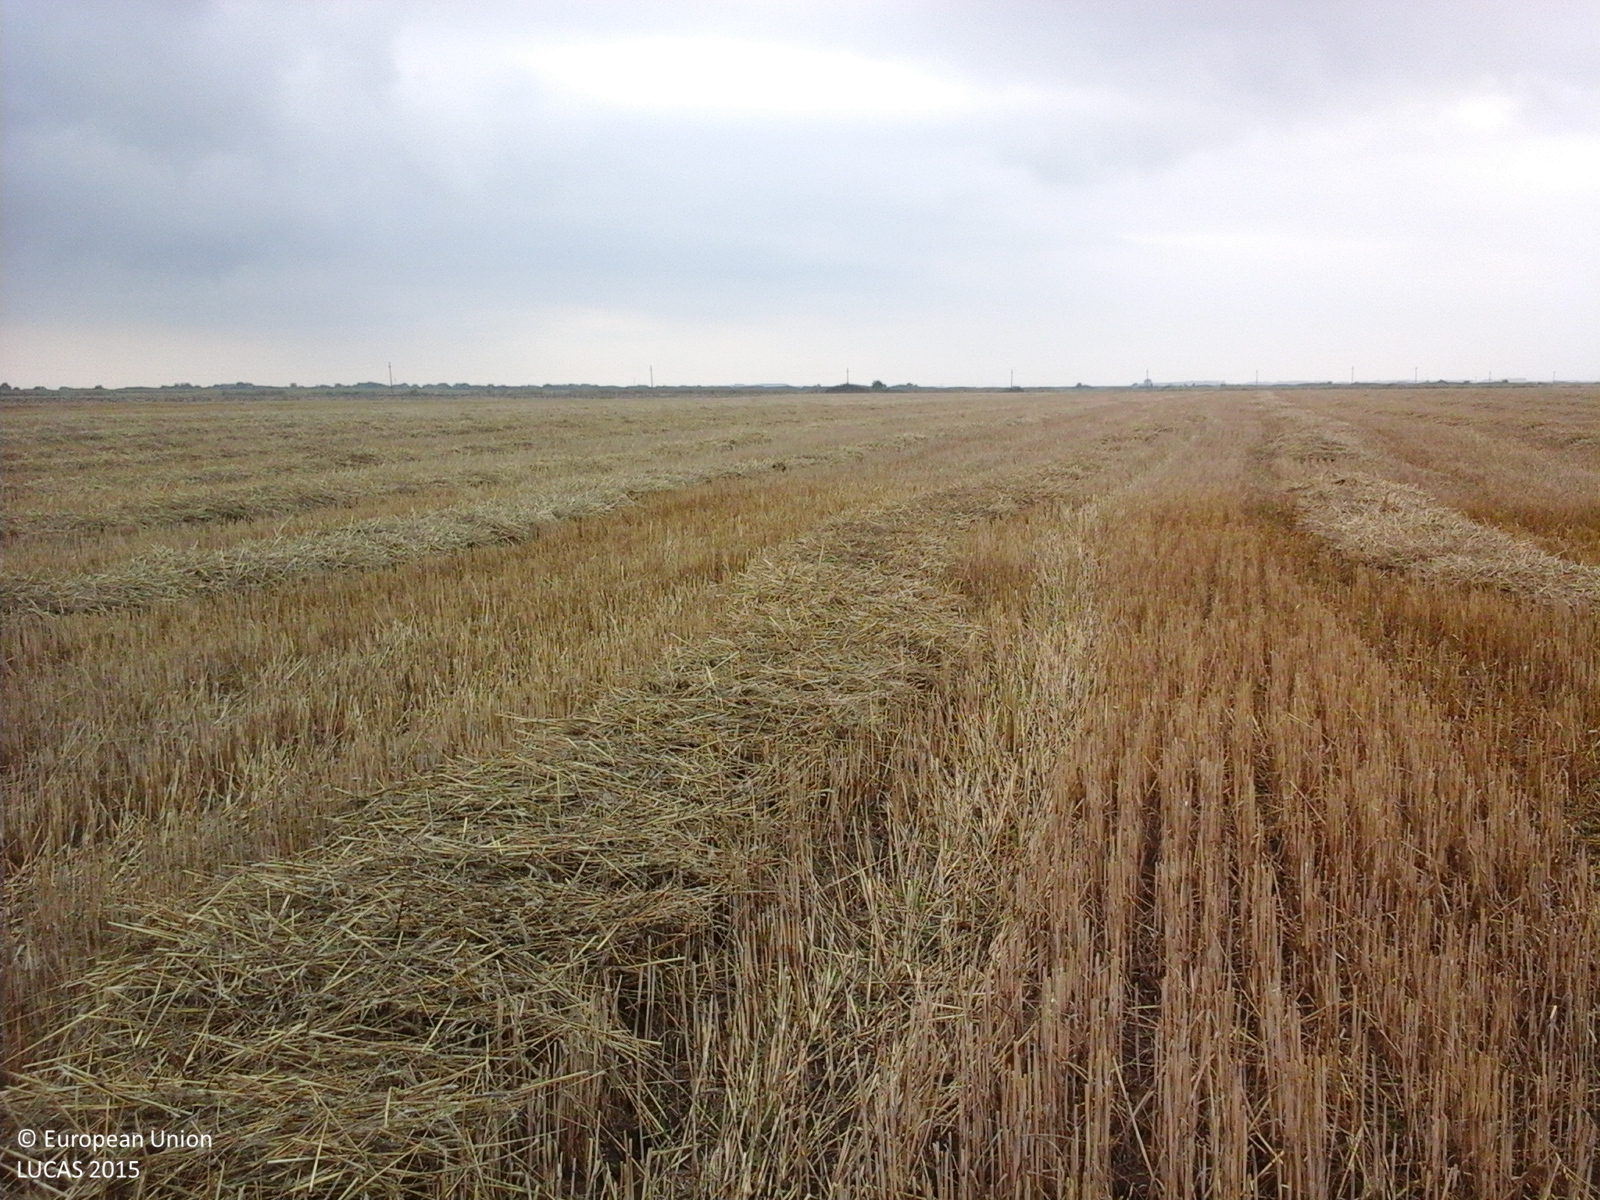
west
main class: Cropland
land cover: Common wheat
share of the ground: < 10 %
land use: Agriculture (excluding fallow land and kitchen gardens)
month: August
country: RO
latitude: 46.1571
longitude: 20.5269
